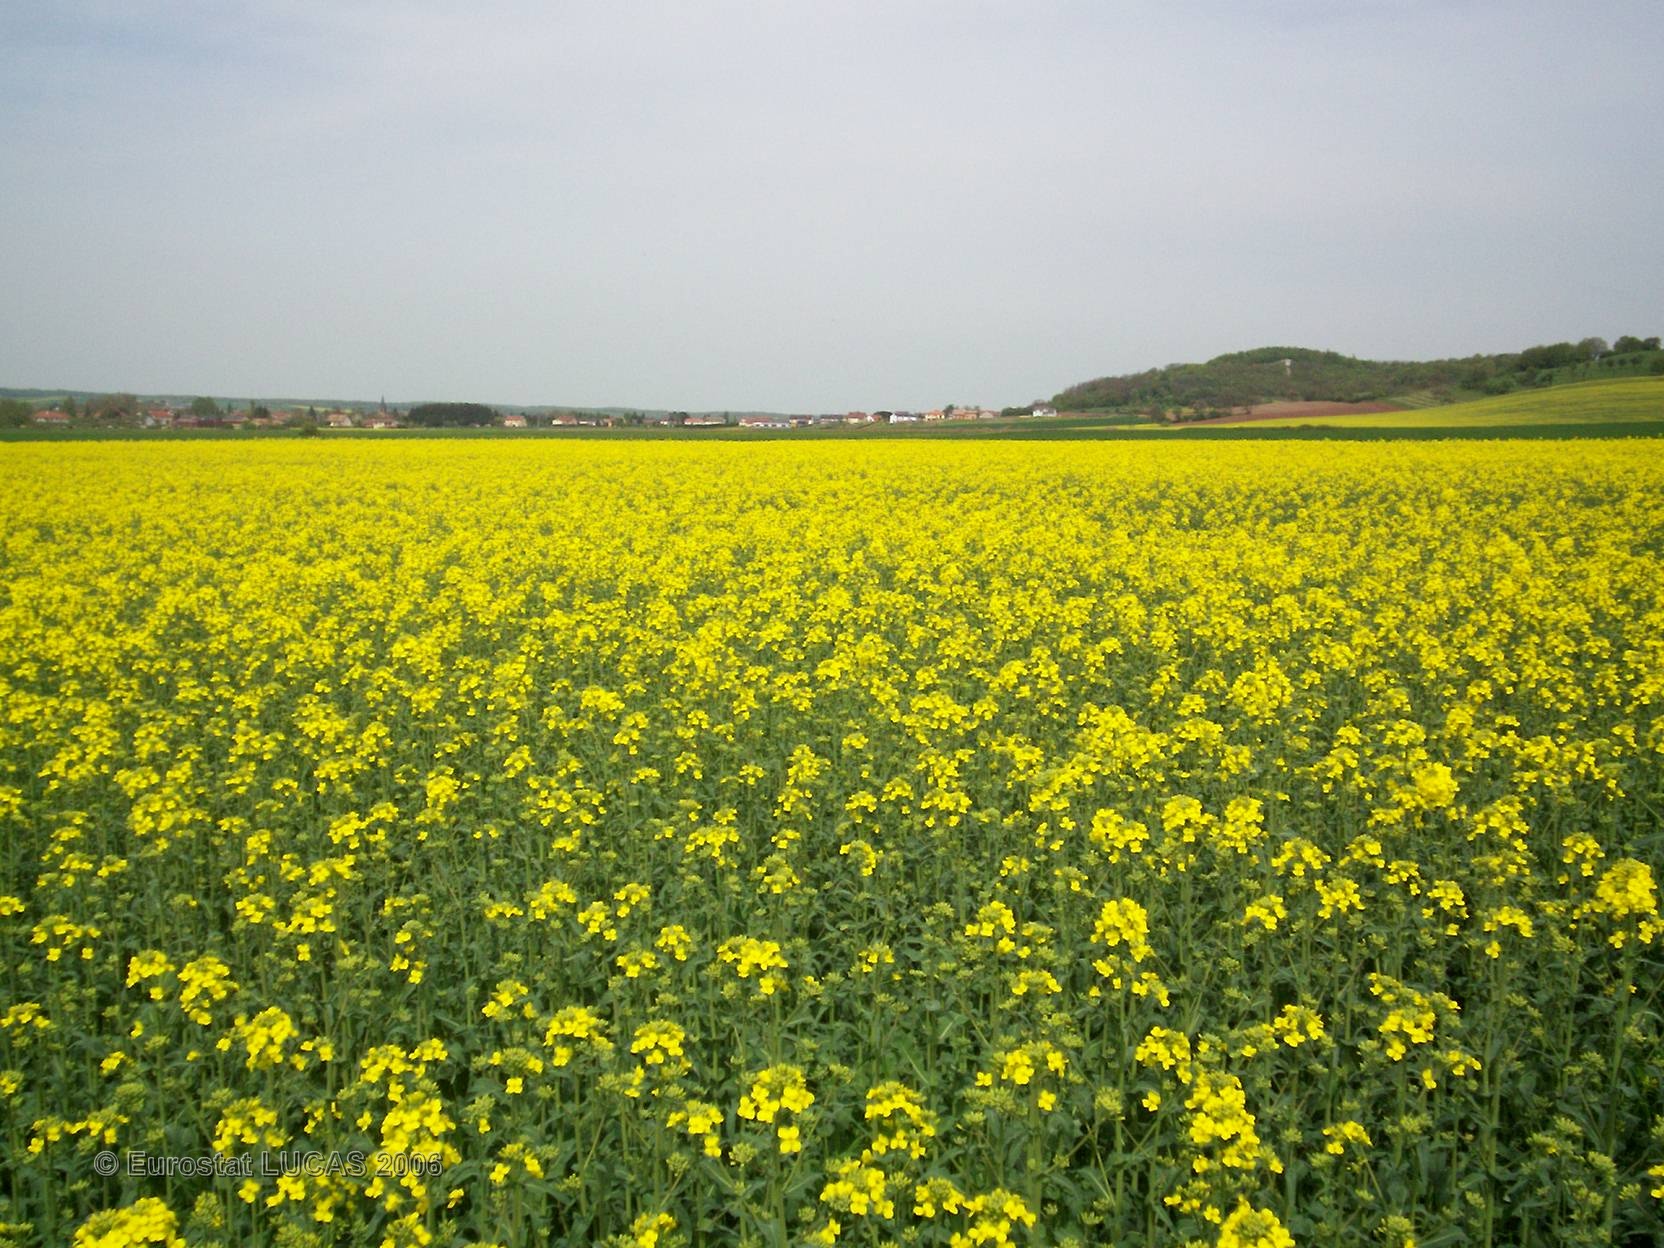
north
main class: Cropland
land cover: Rape and turnip rape
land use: Agriculture (excluding fallow land and kitchen gardens)
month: May
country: FR
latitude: 49.2484
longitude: 6.4969
